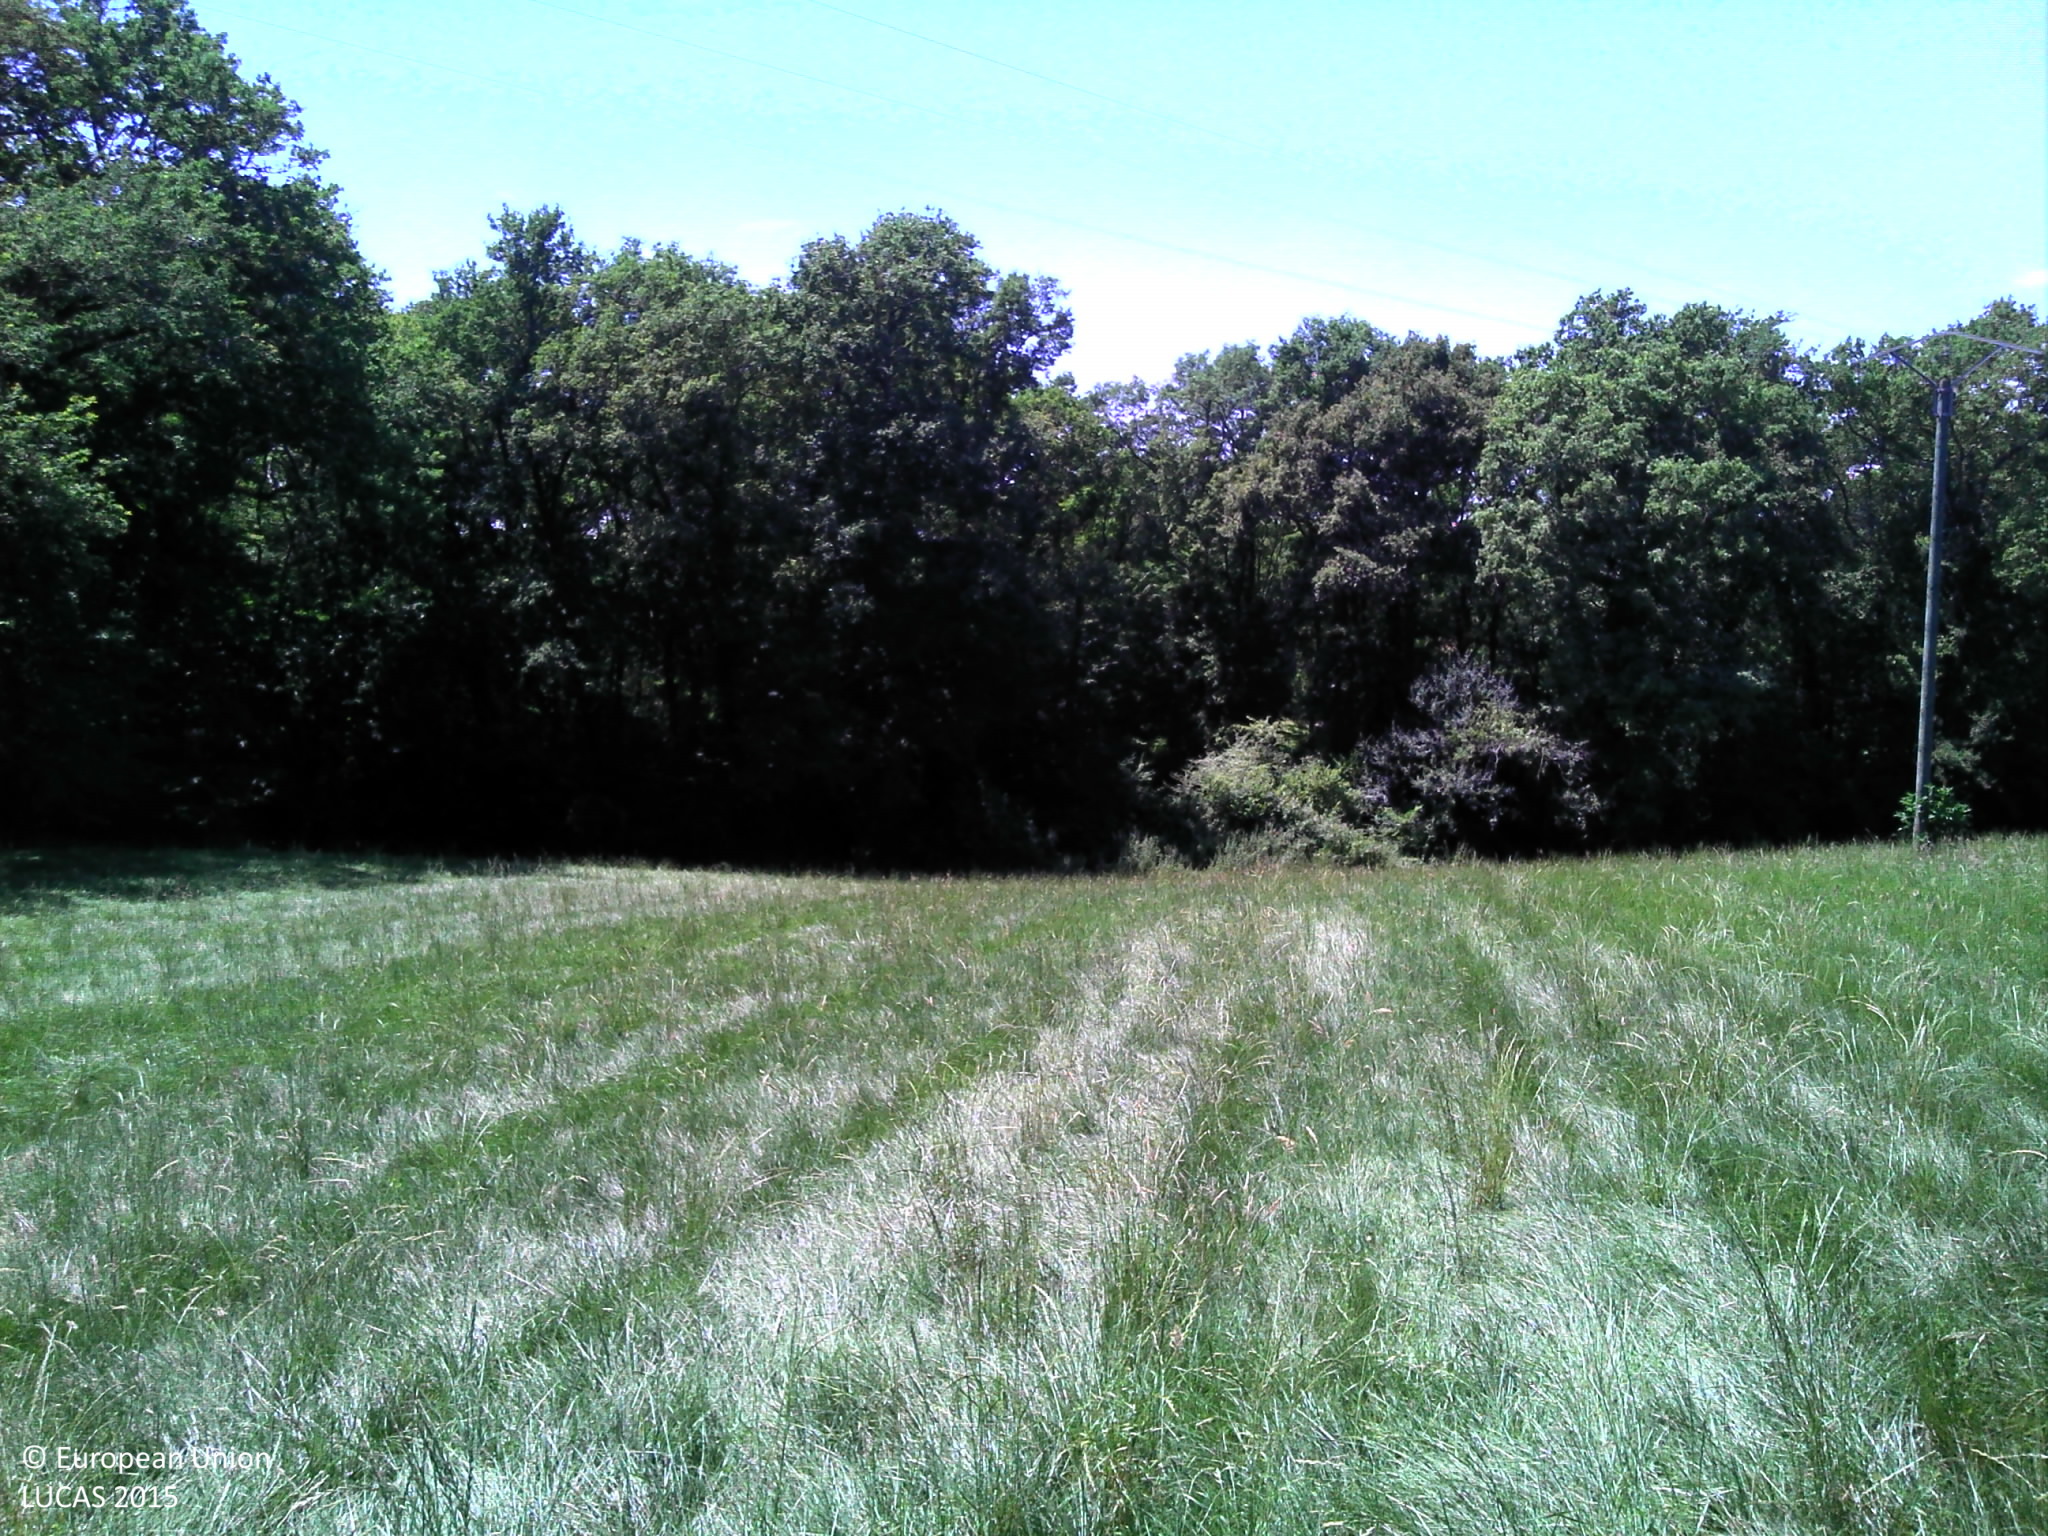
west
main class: Grassland
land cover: Grassland without tree/shrub cover
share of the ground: > 75 %
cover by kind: herbaceous plants 100 %
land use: Agriculture (excluding fallow land and kitchen gardens)
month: June
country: FR
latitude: 43.7127
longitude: -0.4480
